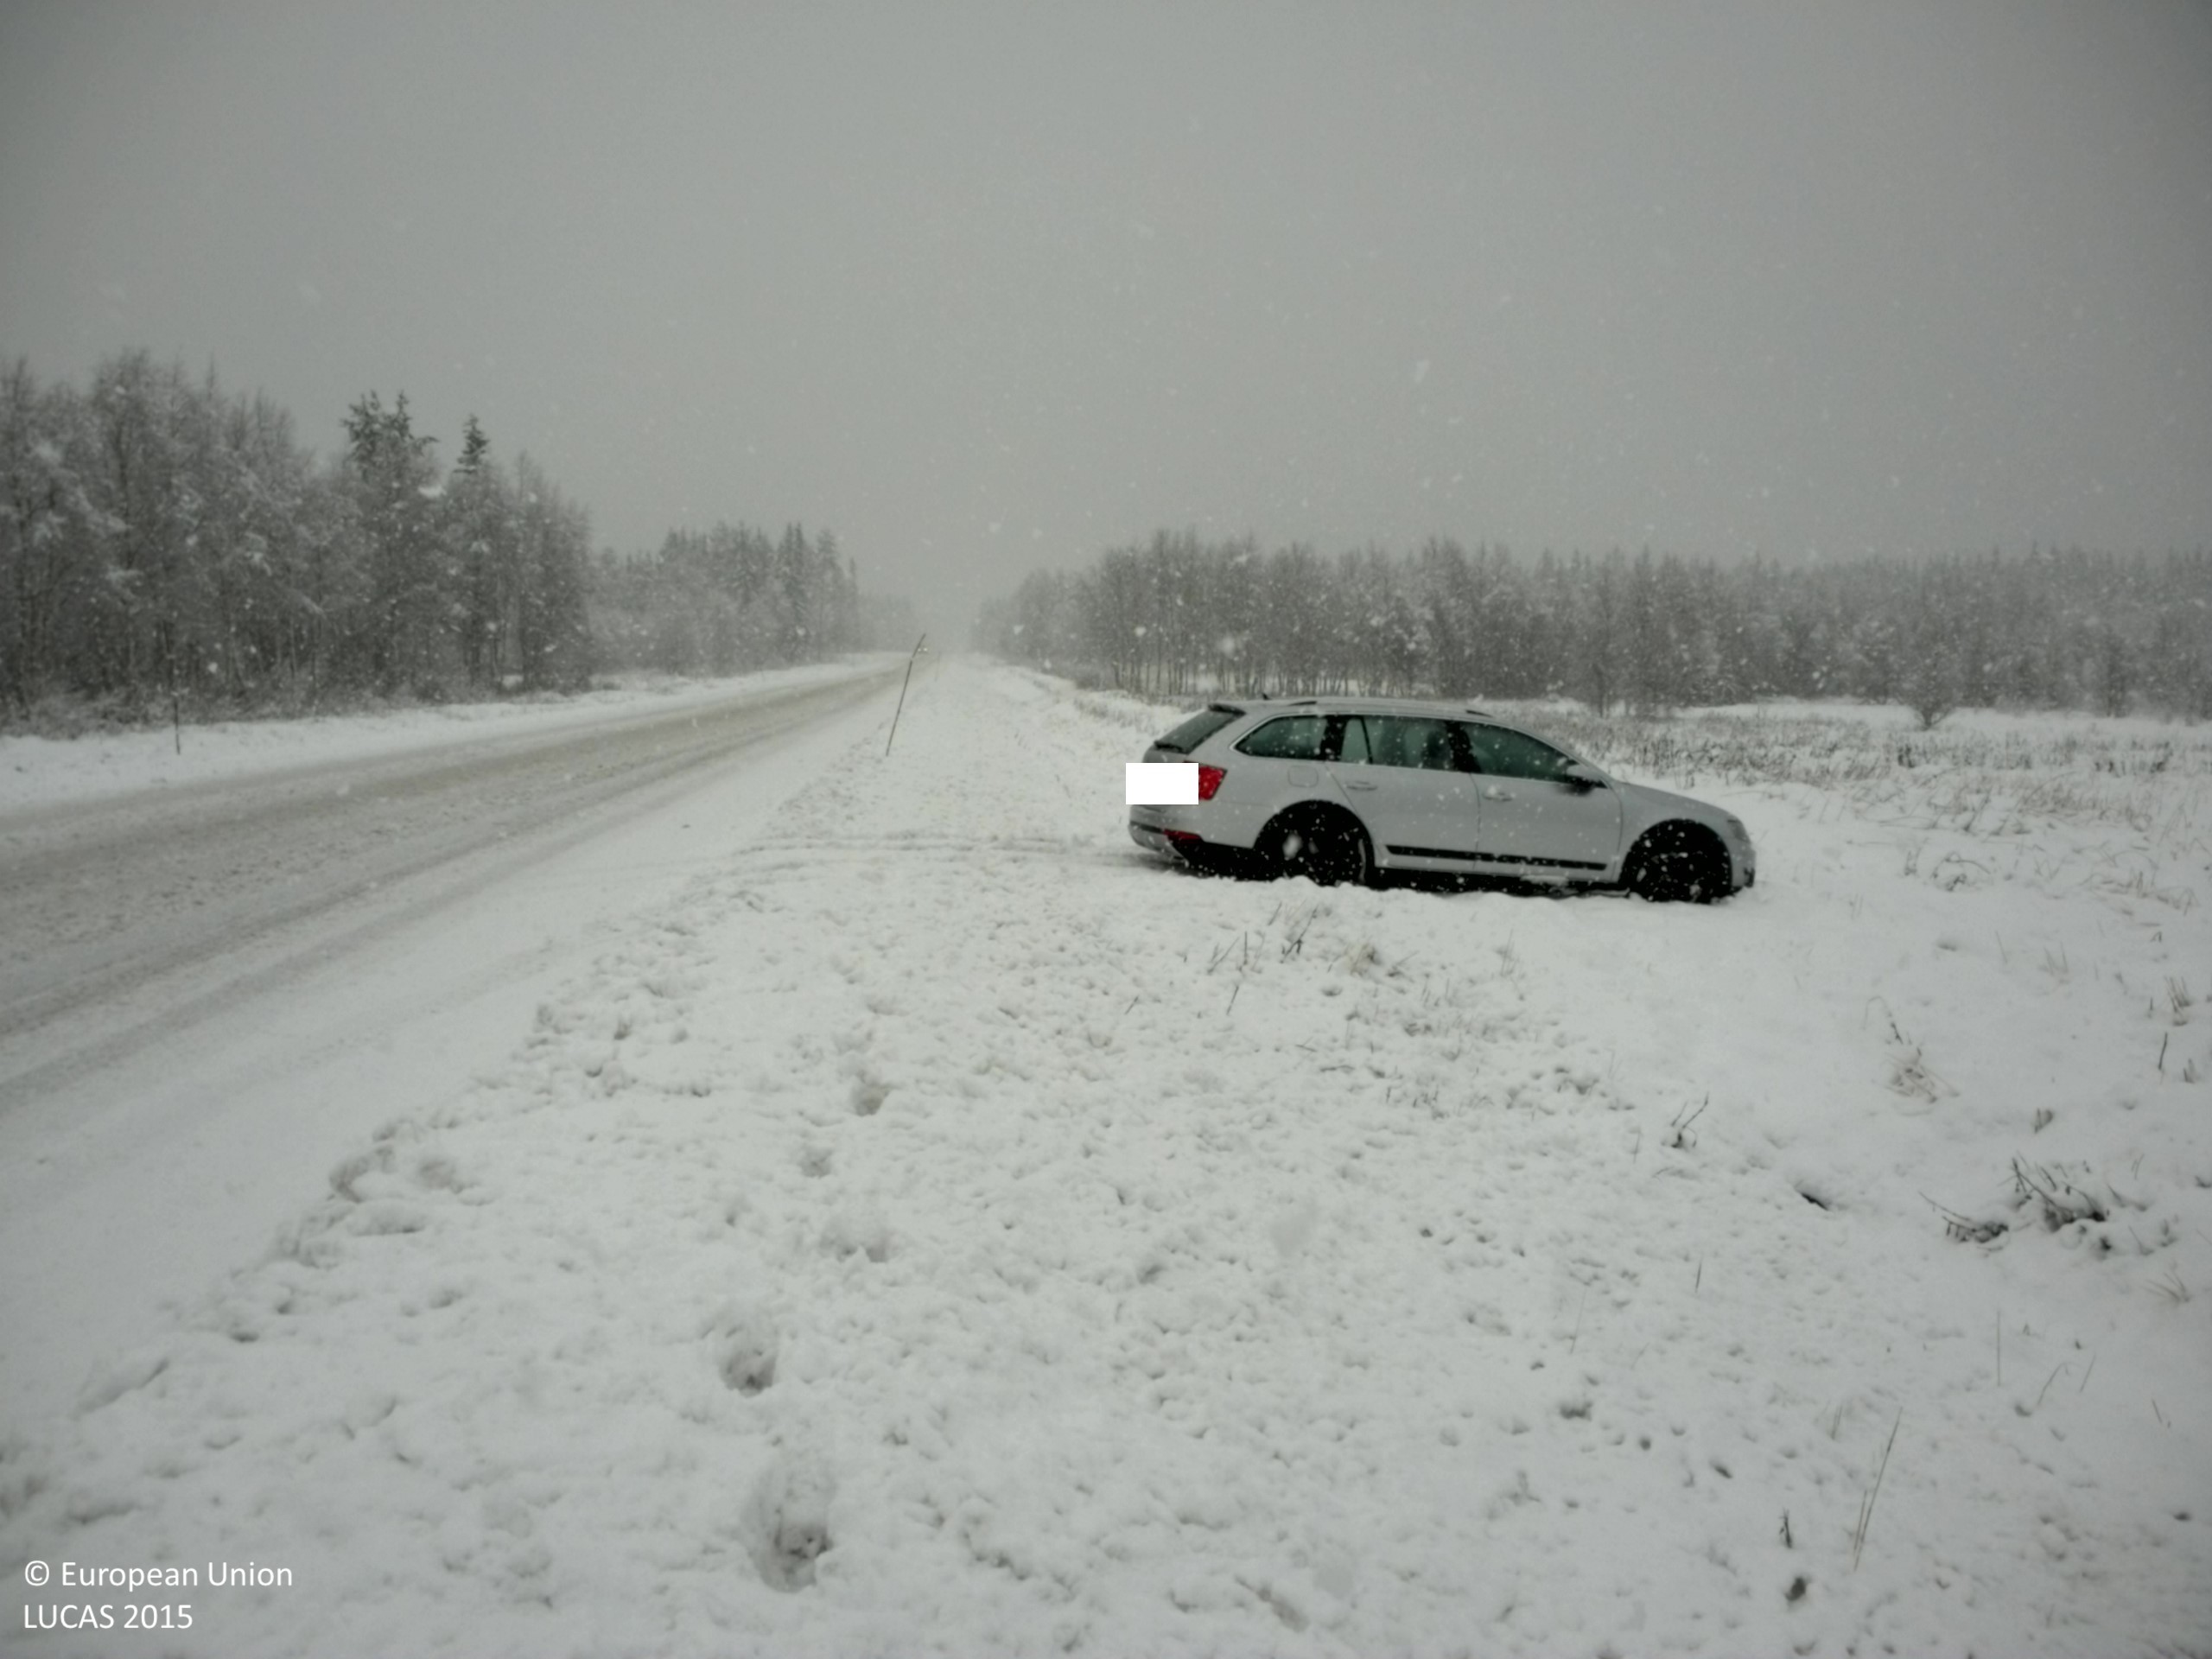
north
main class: Grassland
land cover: Grassland without tree/shrub cover
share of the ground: > 75 %
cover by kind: herbaceous plants 100 %
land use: Road transport
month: November
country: SE
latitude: 63.7955
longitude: 15.5149
